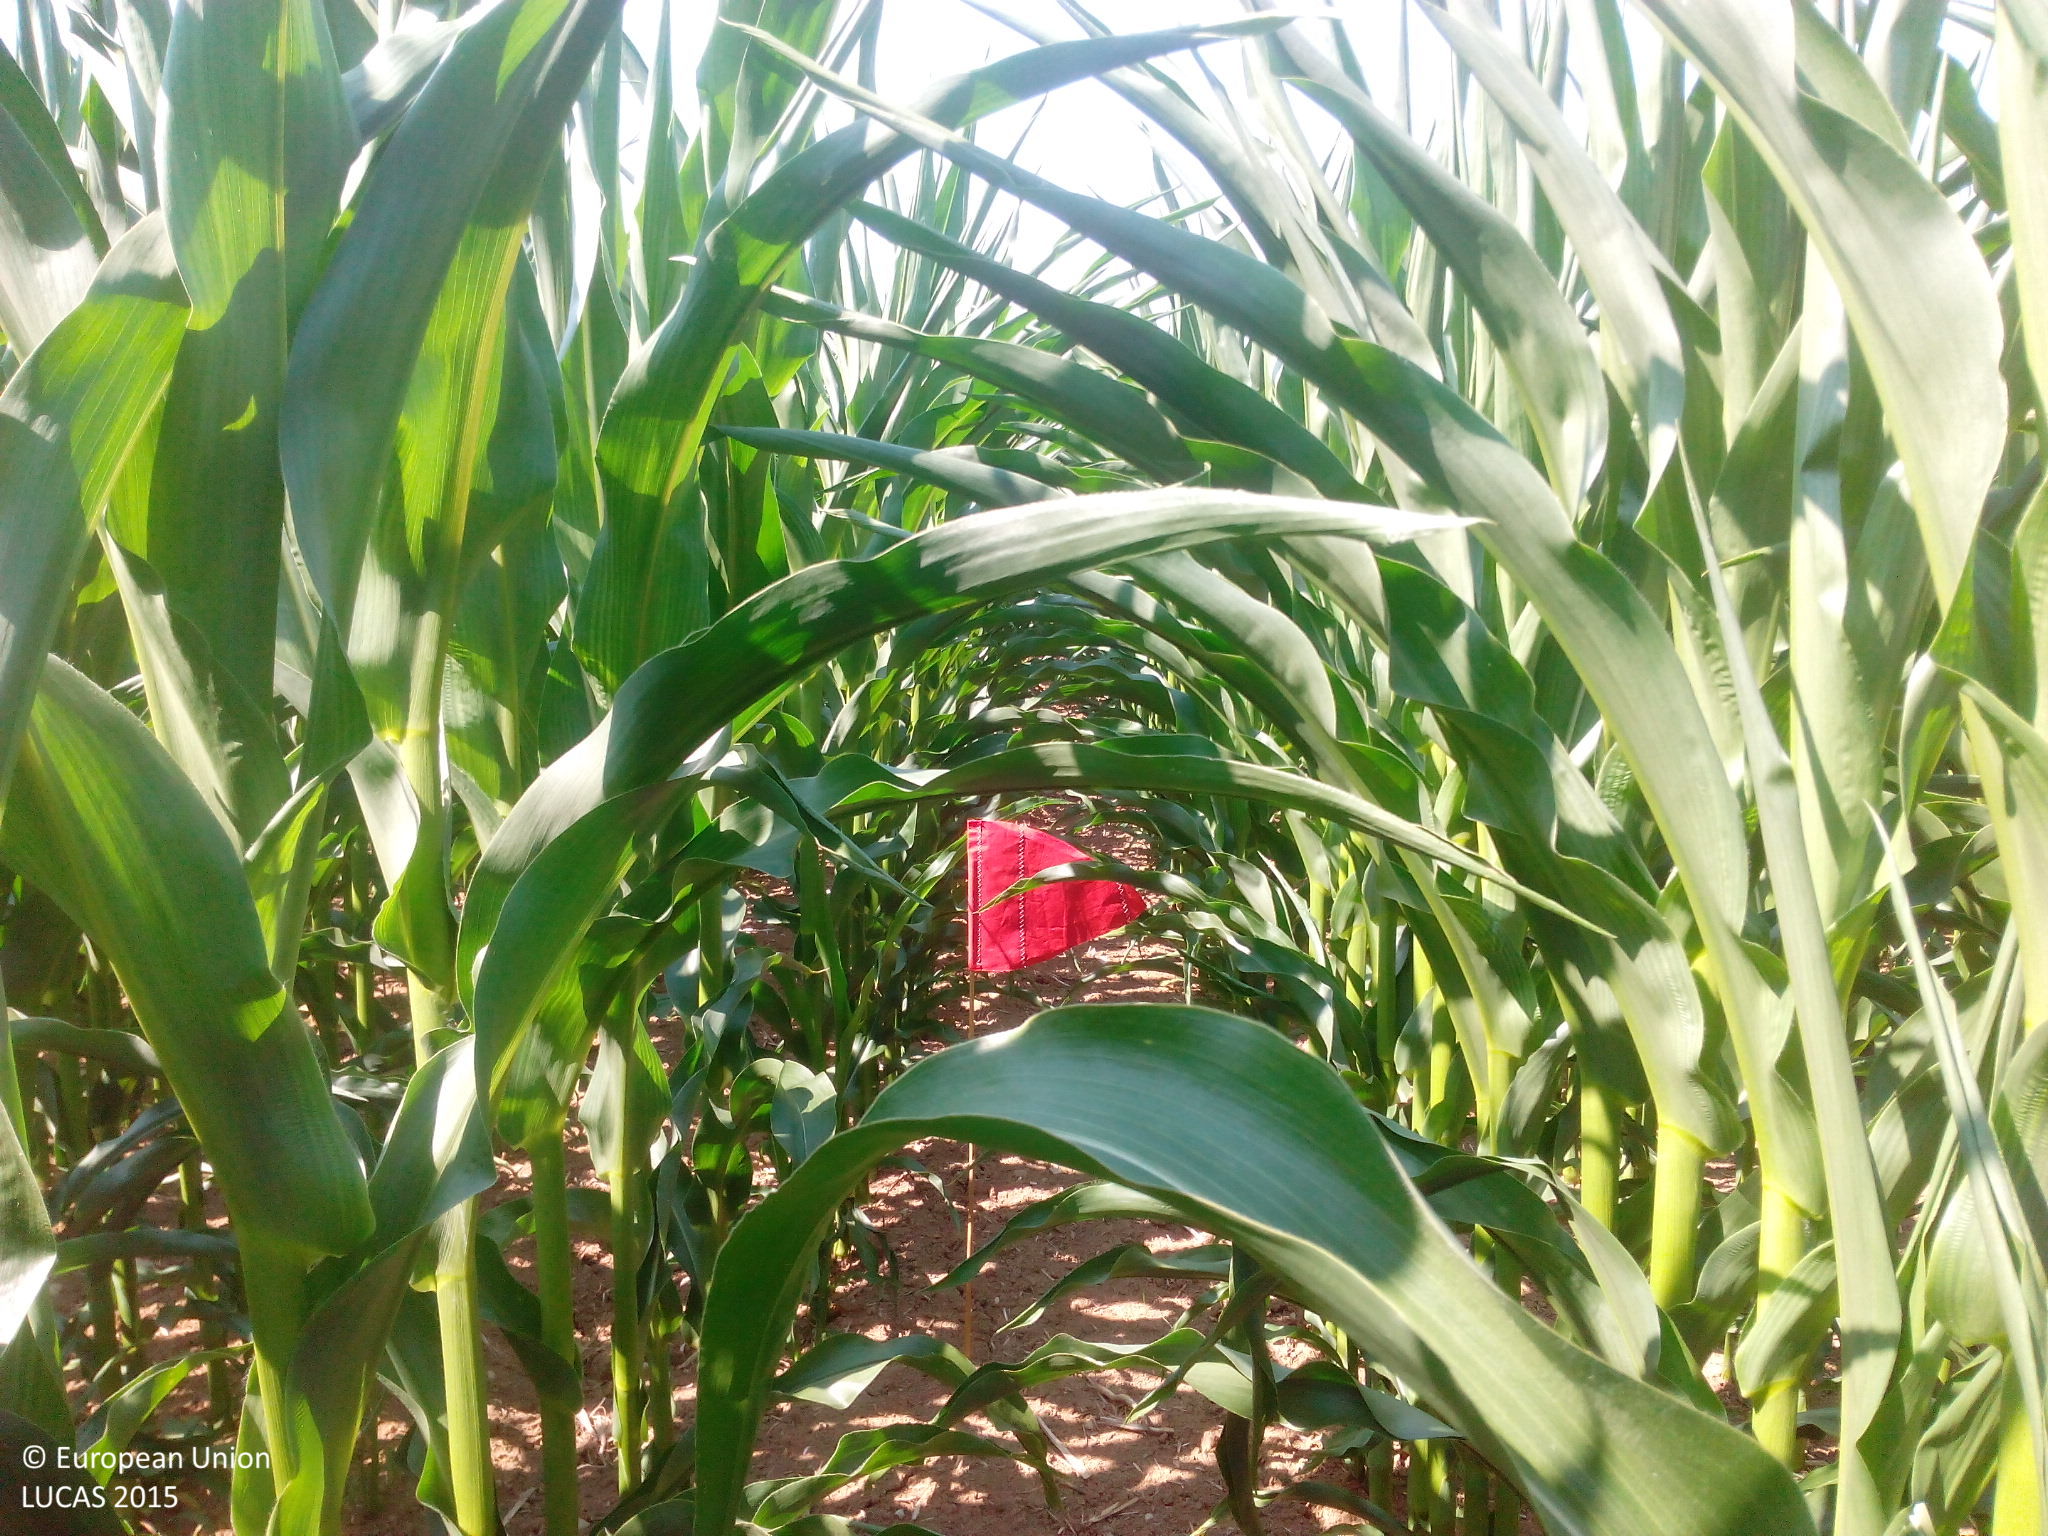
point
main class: Cropland
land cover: Maize
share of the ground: > 75 %
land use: Agriculture (excluding fallow land and kitchen gardens)
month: July
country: DE
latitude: 49.4468
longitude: 9.9035
